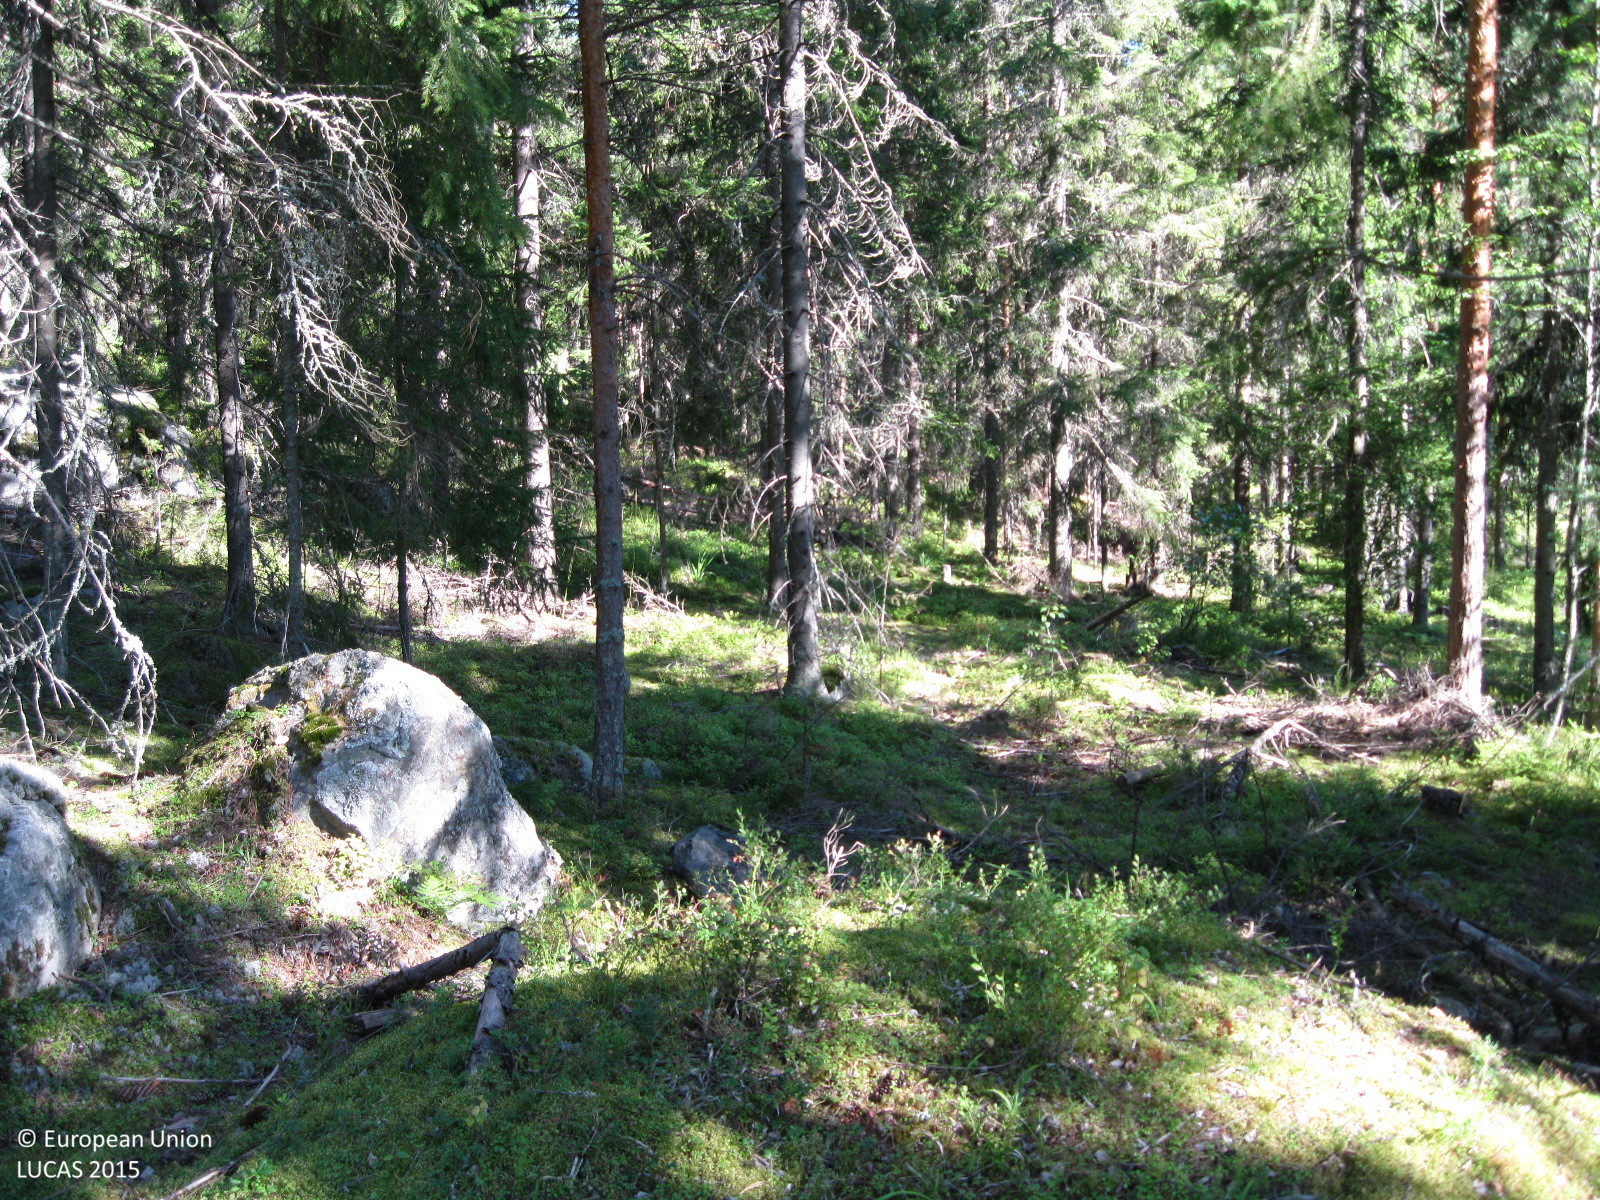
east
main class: Woodland
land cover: Spruce dominated coniferous woodland
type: boreal forest
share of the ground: > 75 %
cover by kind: coniferous forest trees 75 %, lichens and mosses 15 %, shrubs 5 %, herbaceous plants 5 %
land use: Forestry
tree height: > 5 m
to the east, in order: Spruce dominated coniferous woodland; Pine dominated coniferous woodland; Tracks; Pine dominated coniferous woodland; Other coniferous woodland
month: August
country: FI
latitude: 61.4264
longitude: 25.3944
